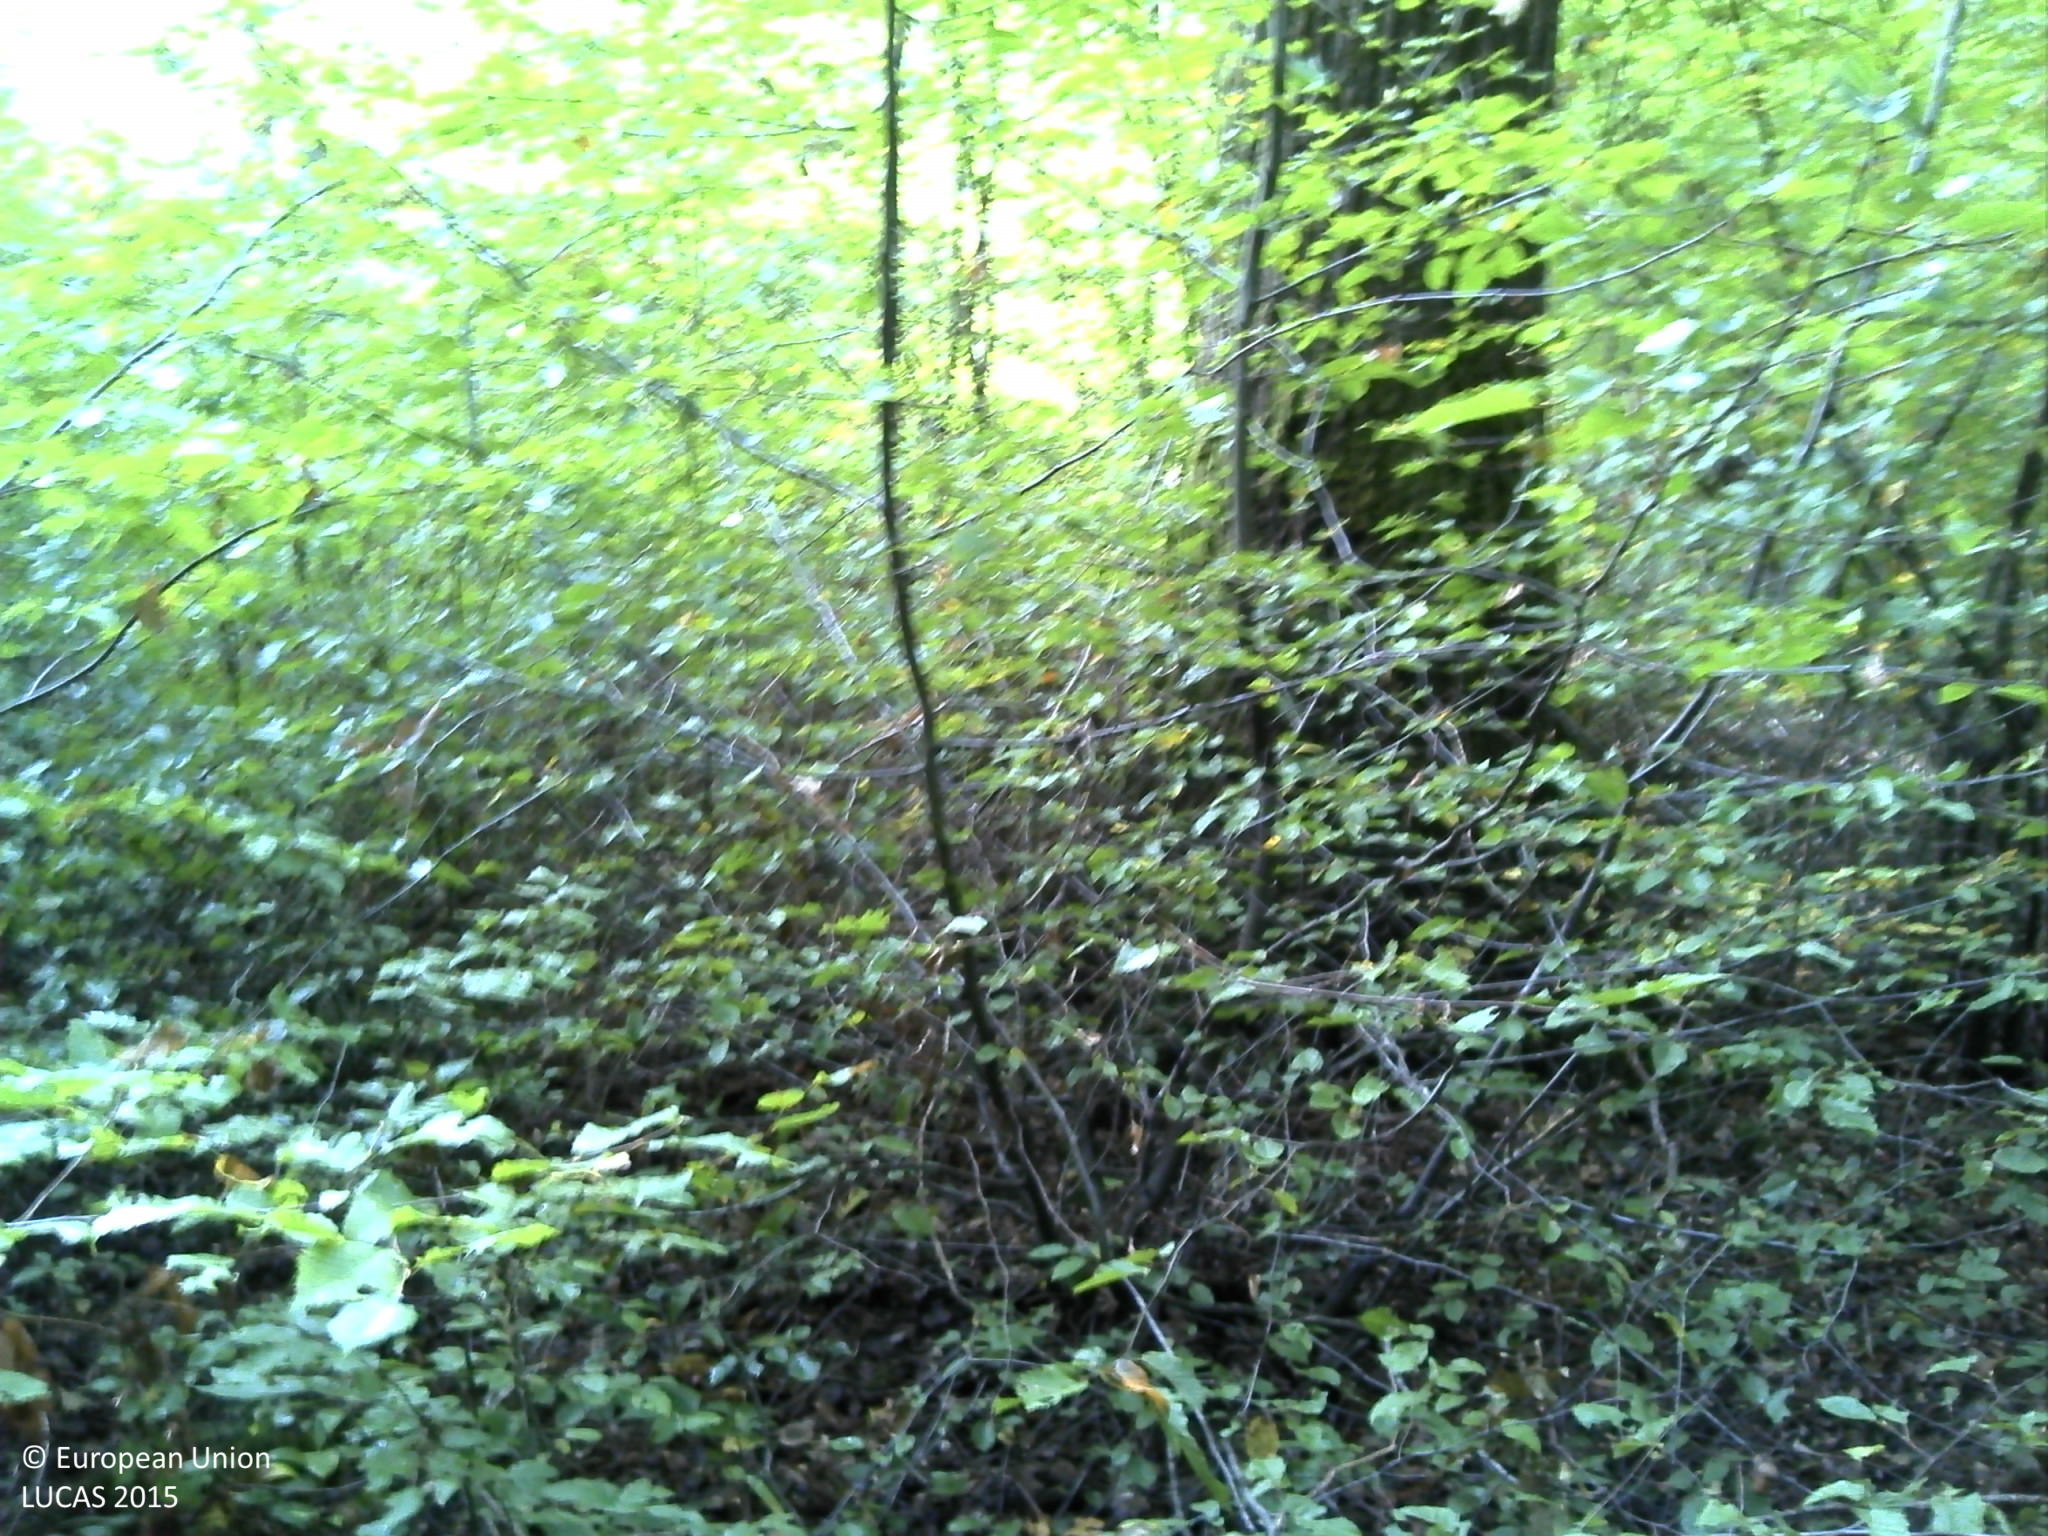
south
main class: Woodland
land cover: Broadleaved woodland
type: acidophilous oak and oak-birch forest
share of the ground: > 75 %
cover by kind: broadleaved forest trees 85 %, herbaceous plants 15 %
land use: Forestry
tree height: > 5 m
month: June
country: FR
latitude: 46.6919
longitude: 4.7577
